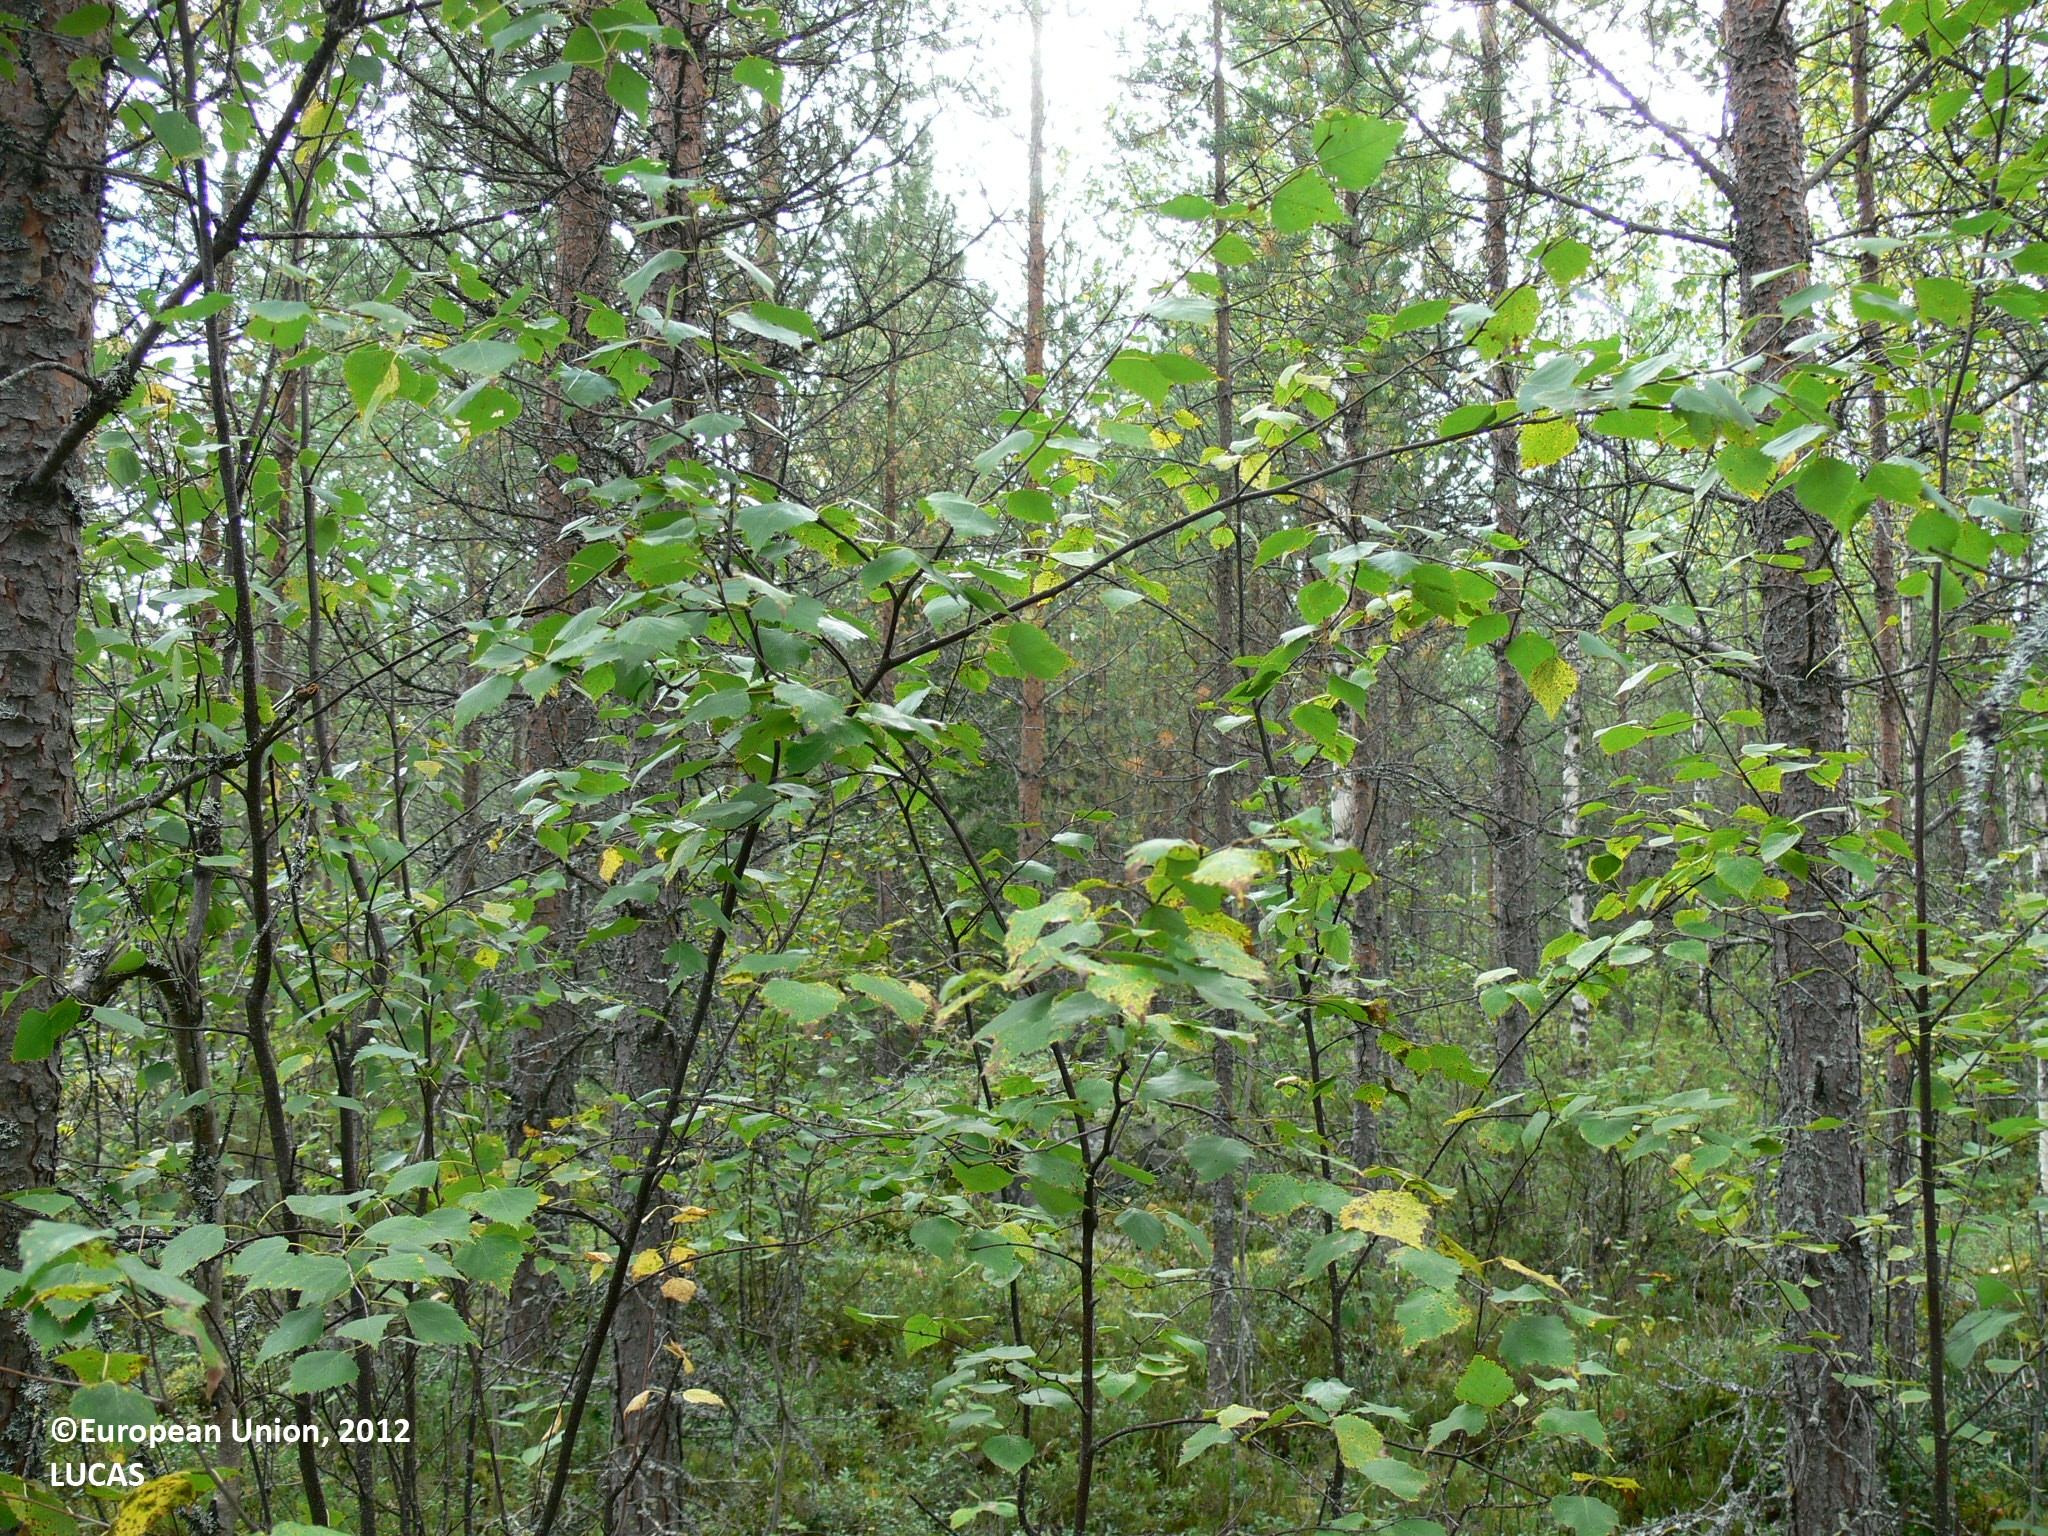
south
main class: Woodland
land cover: Other mixed woodland
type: boreal forest
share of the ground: > 75 %
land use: Forestry
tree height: > 5 m
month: August
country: FI
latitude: 63.2861
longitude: 30.3025
